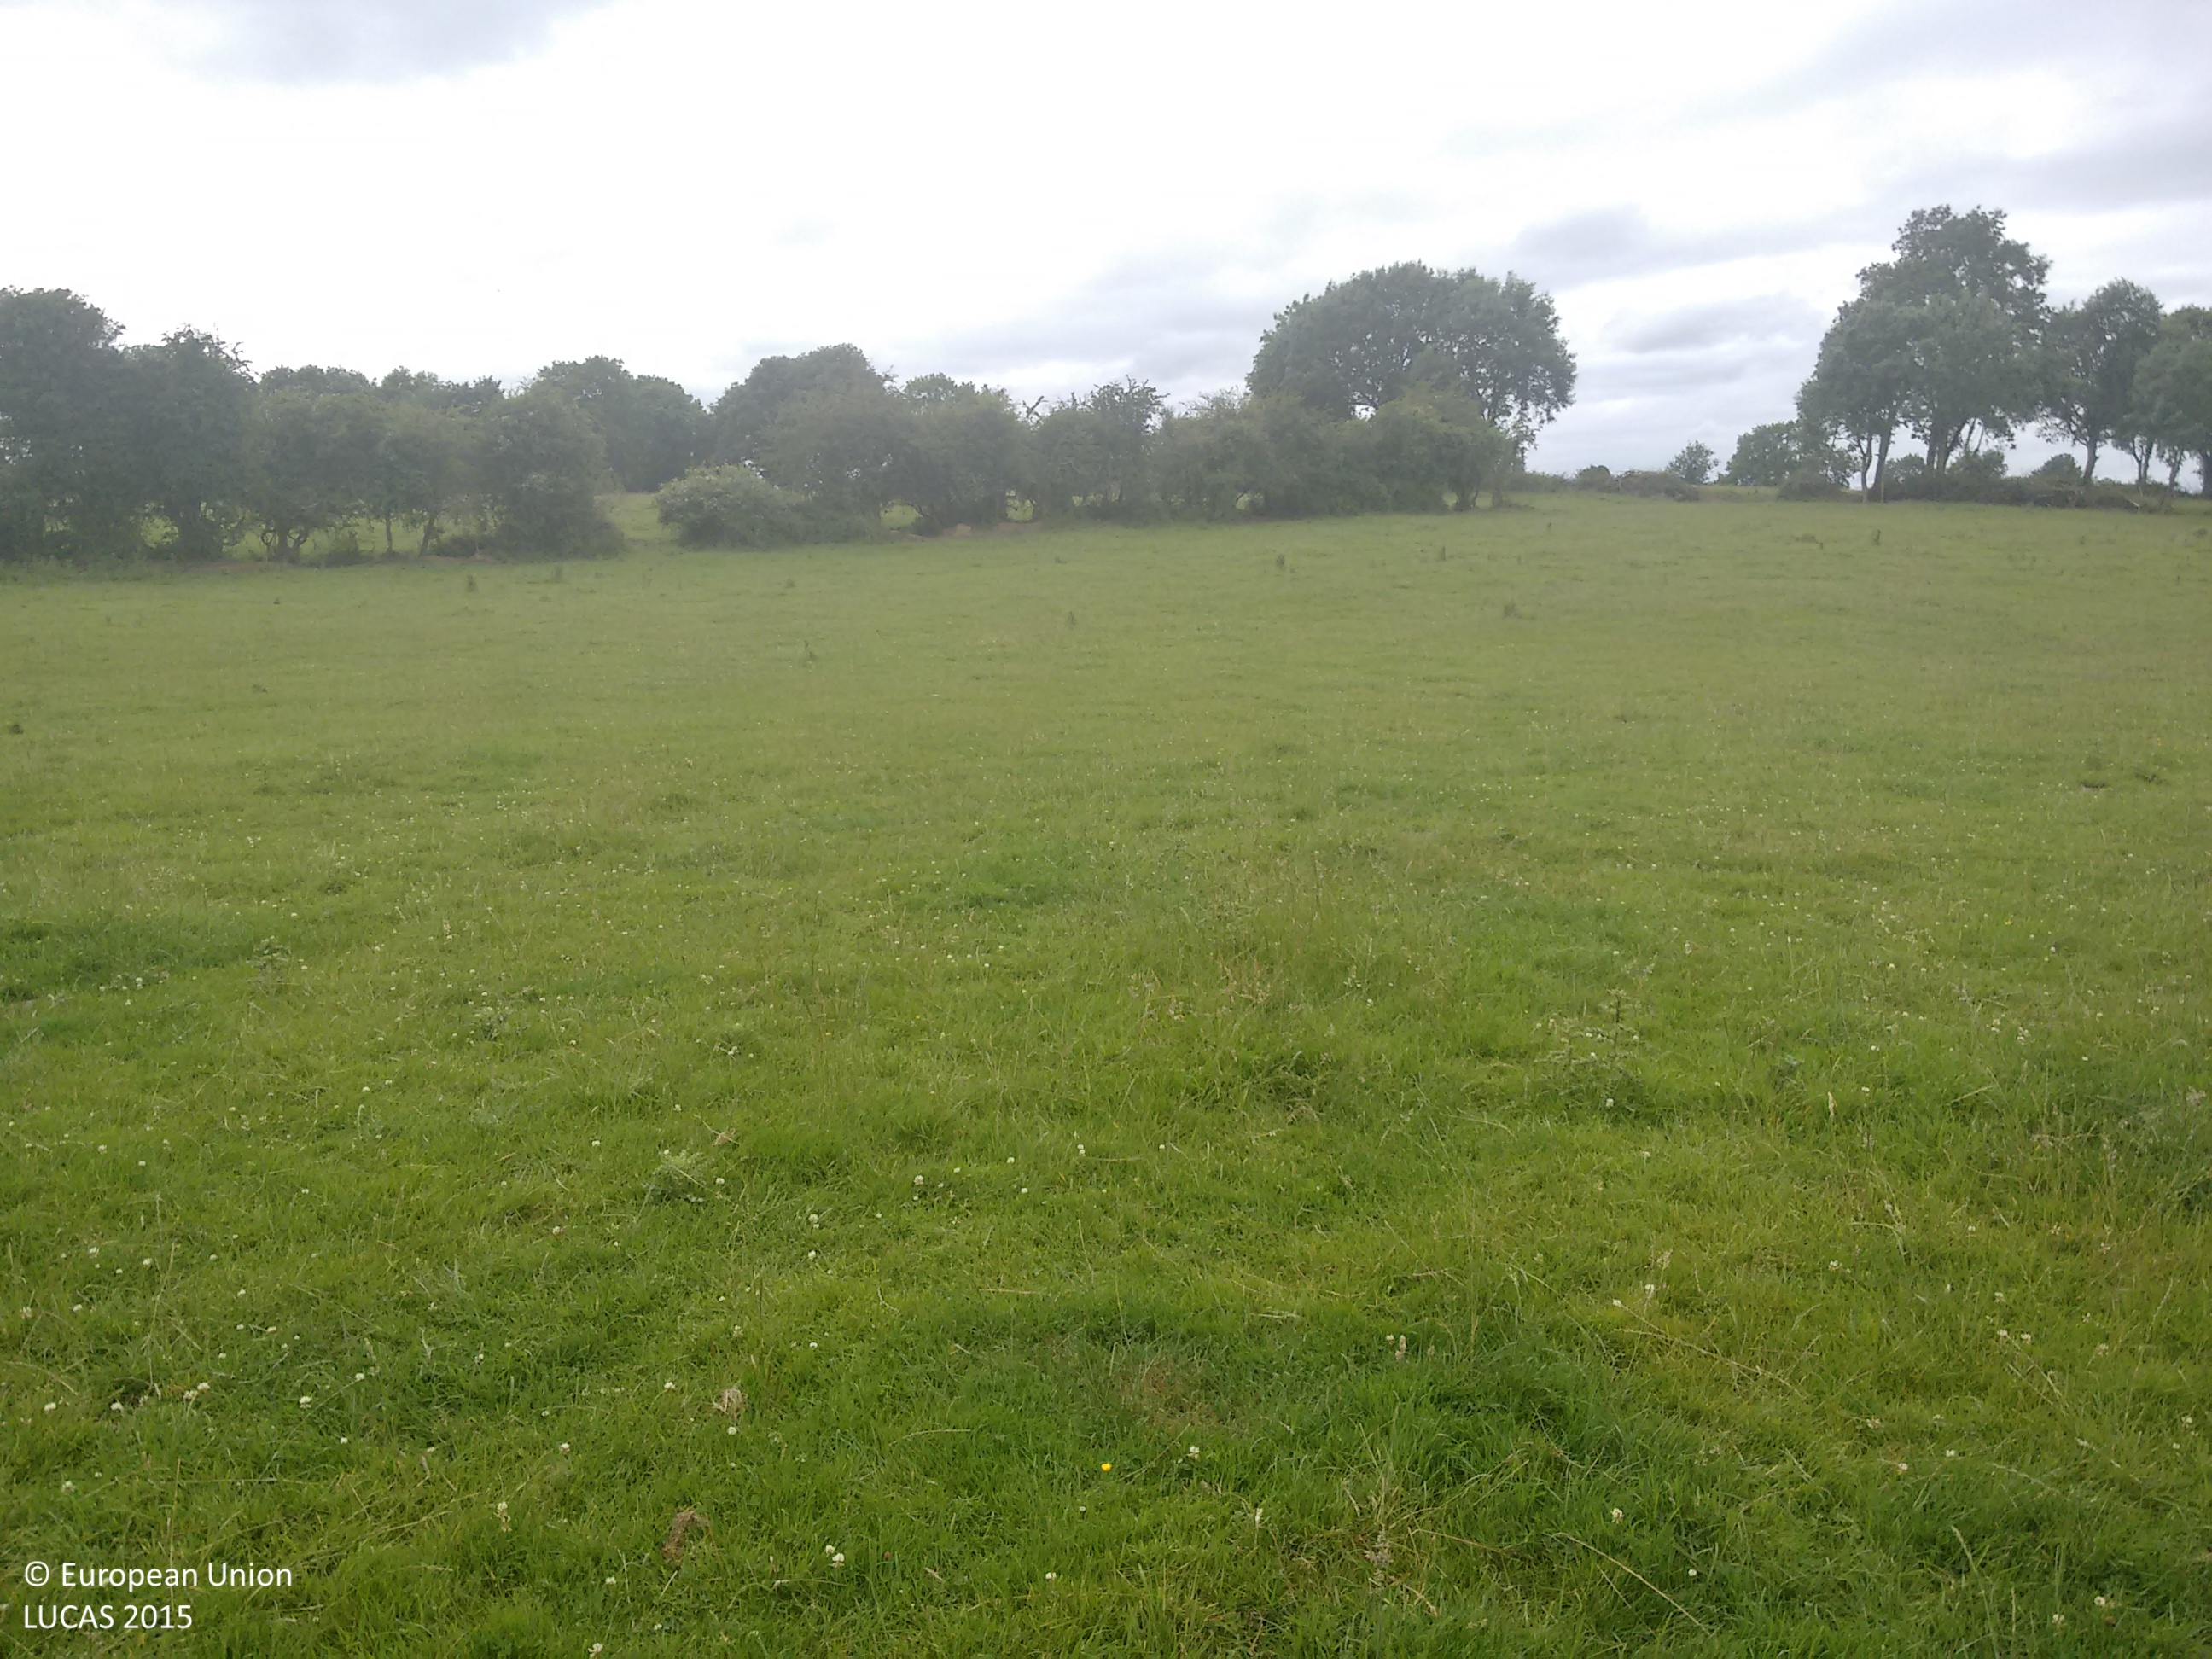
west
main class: Grassland
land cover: Grassland without tree/shrub cover
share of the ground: > 75 %
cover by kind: herbaceous plants 100 %
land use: Agriculture (excluding fallow land and kitchen gardens)
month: July
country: IE
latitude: 53.5069
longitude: -7.6691
